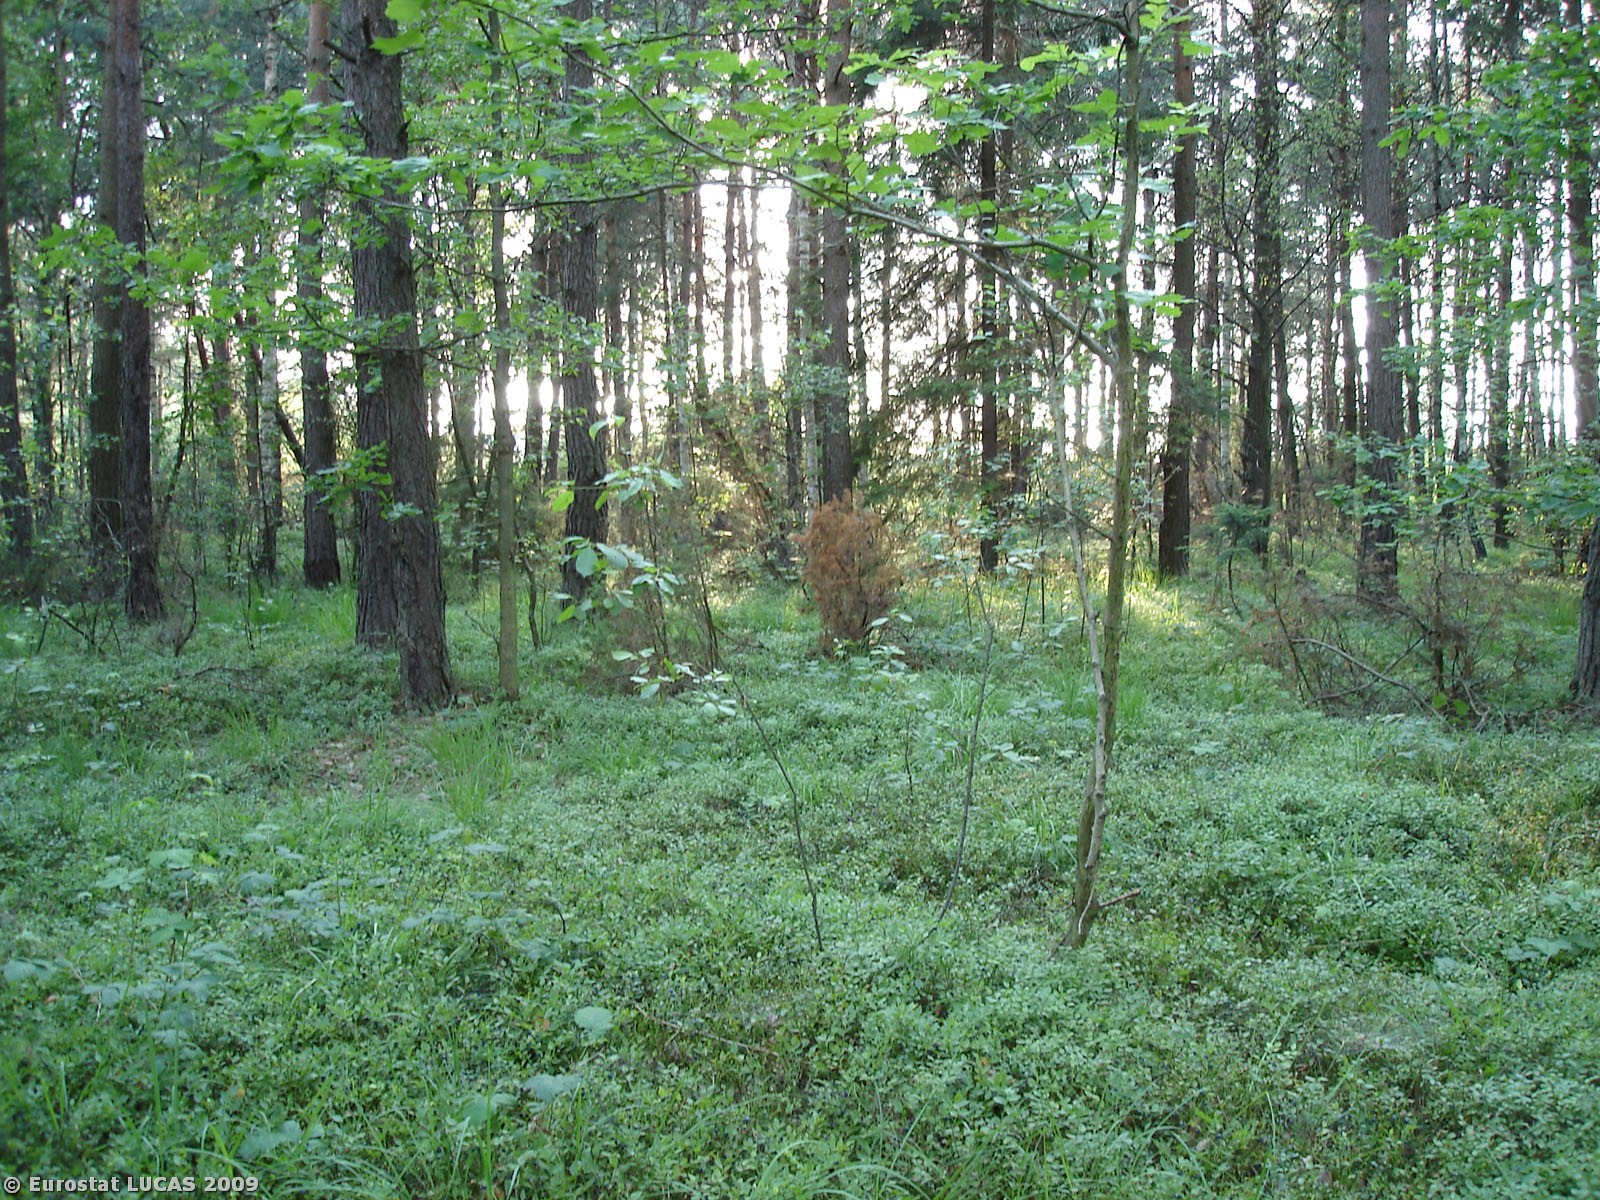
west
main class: Woodland
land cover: Mixed woodland
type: hemiboreal forest and nemoral coniferous forest and mixed broadleaved-coniferous forest
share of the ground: > 75 %
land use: Forestry
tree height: > 5 m
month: March
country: PL
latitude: 50.9307
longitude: 19.8920
